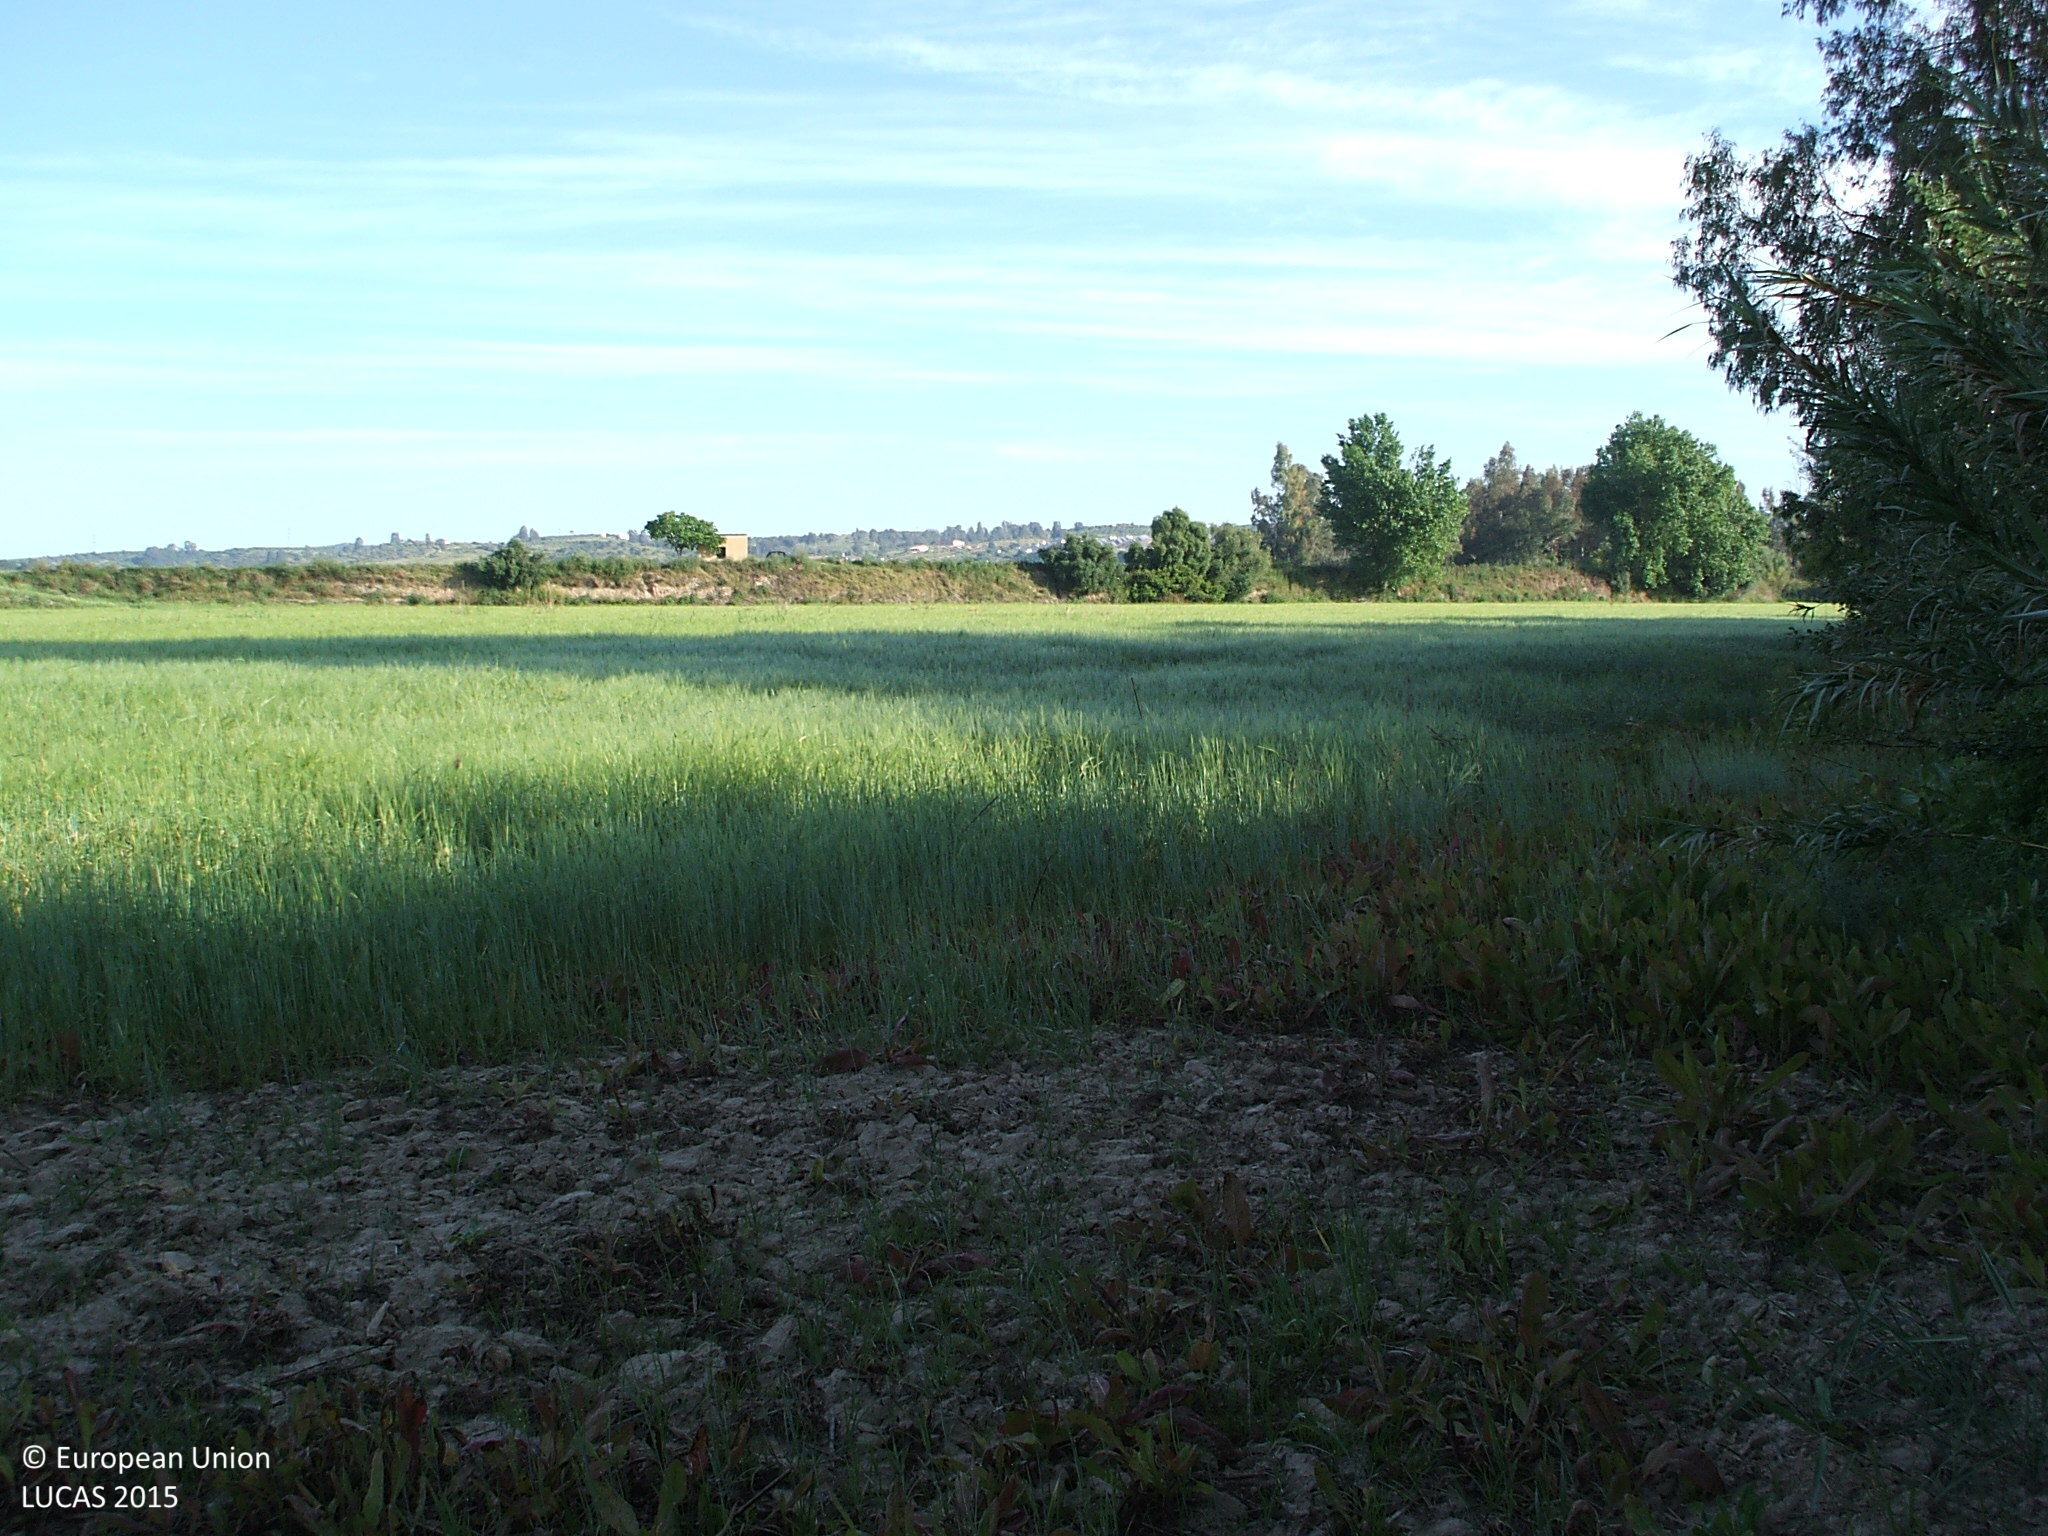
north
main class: Woodland
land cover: Broadleaved woodland
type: exotic forest
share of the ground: 10 - 25 %
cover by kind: shrubs 85 %, broadleaved forest trees 15 %
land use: Semi-natural and natural areas not in use
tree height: > 5 m
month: April
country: ES
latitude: 37.6088
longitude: -5.6205
